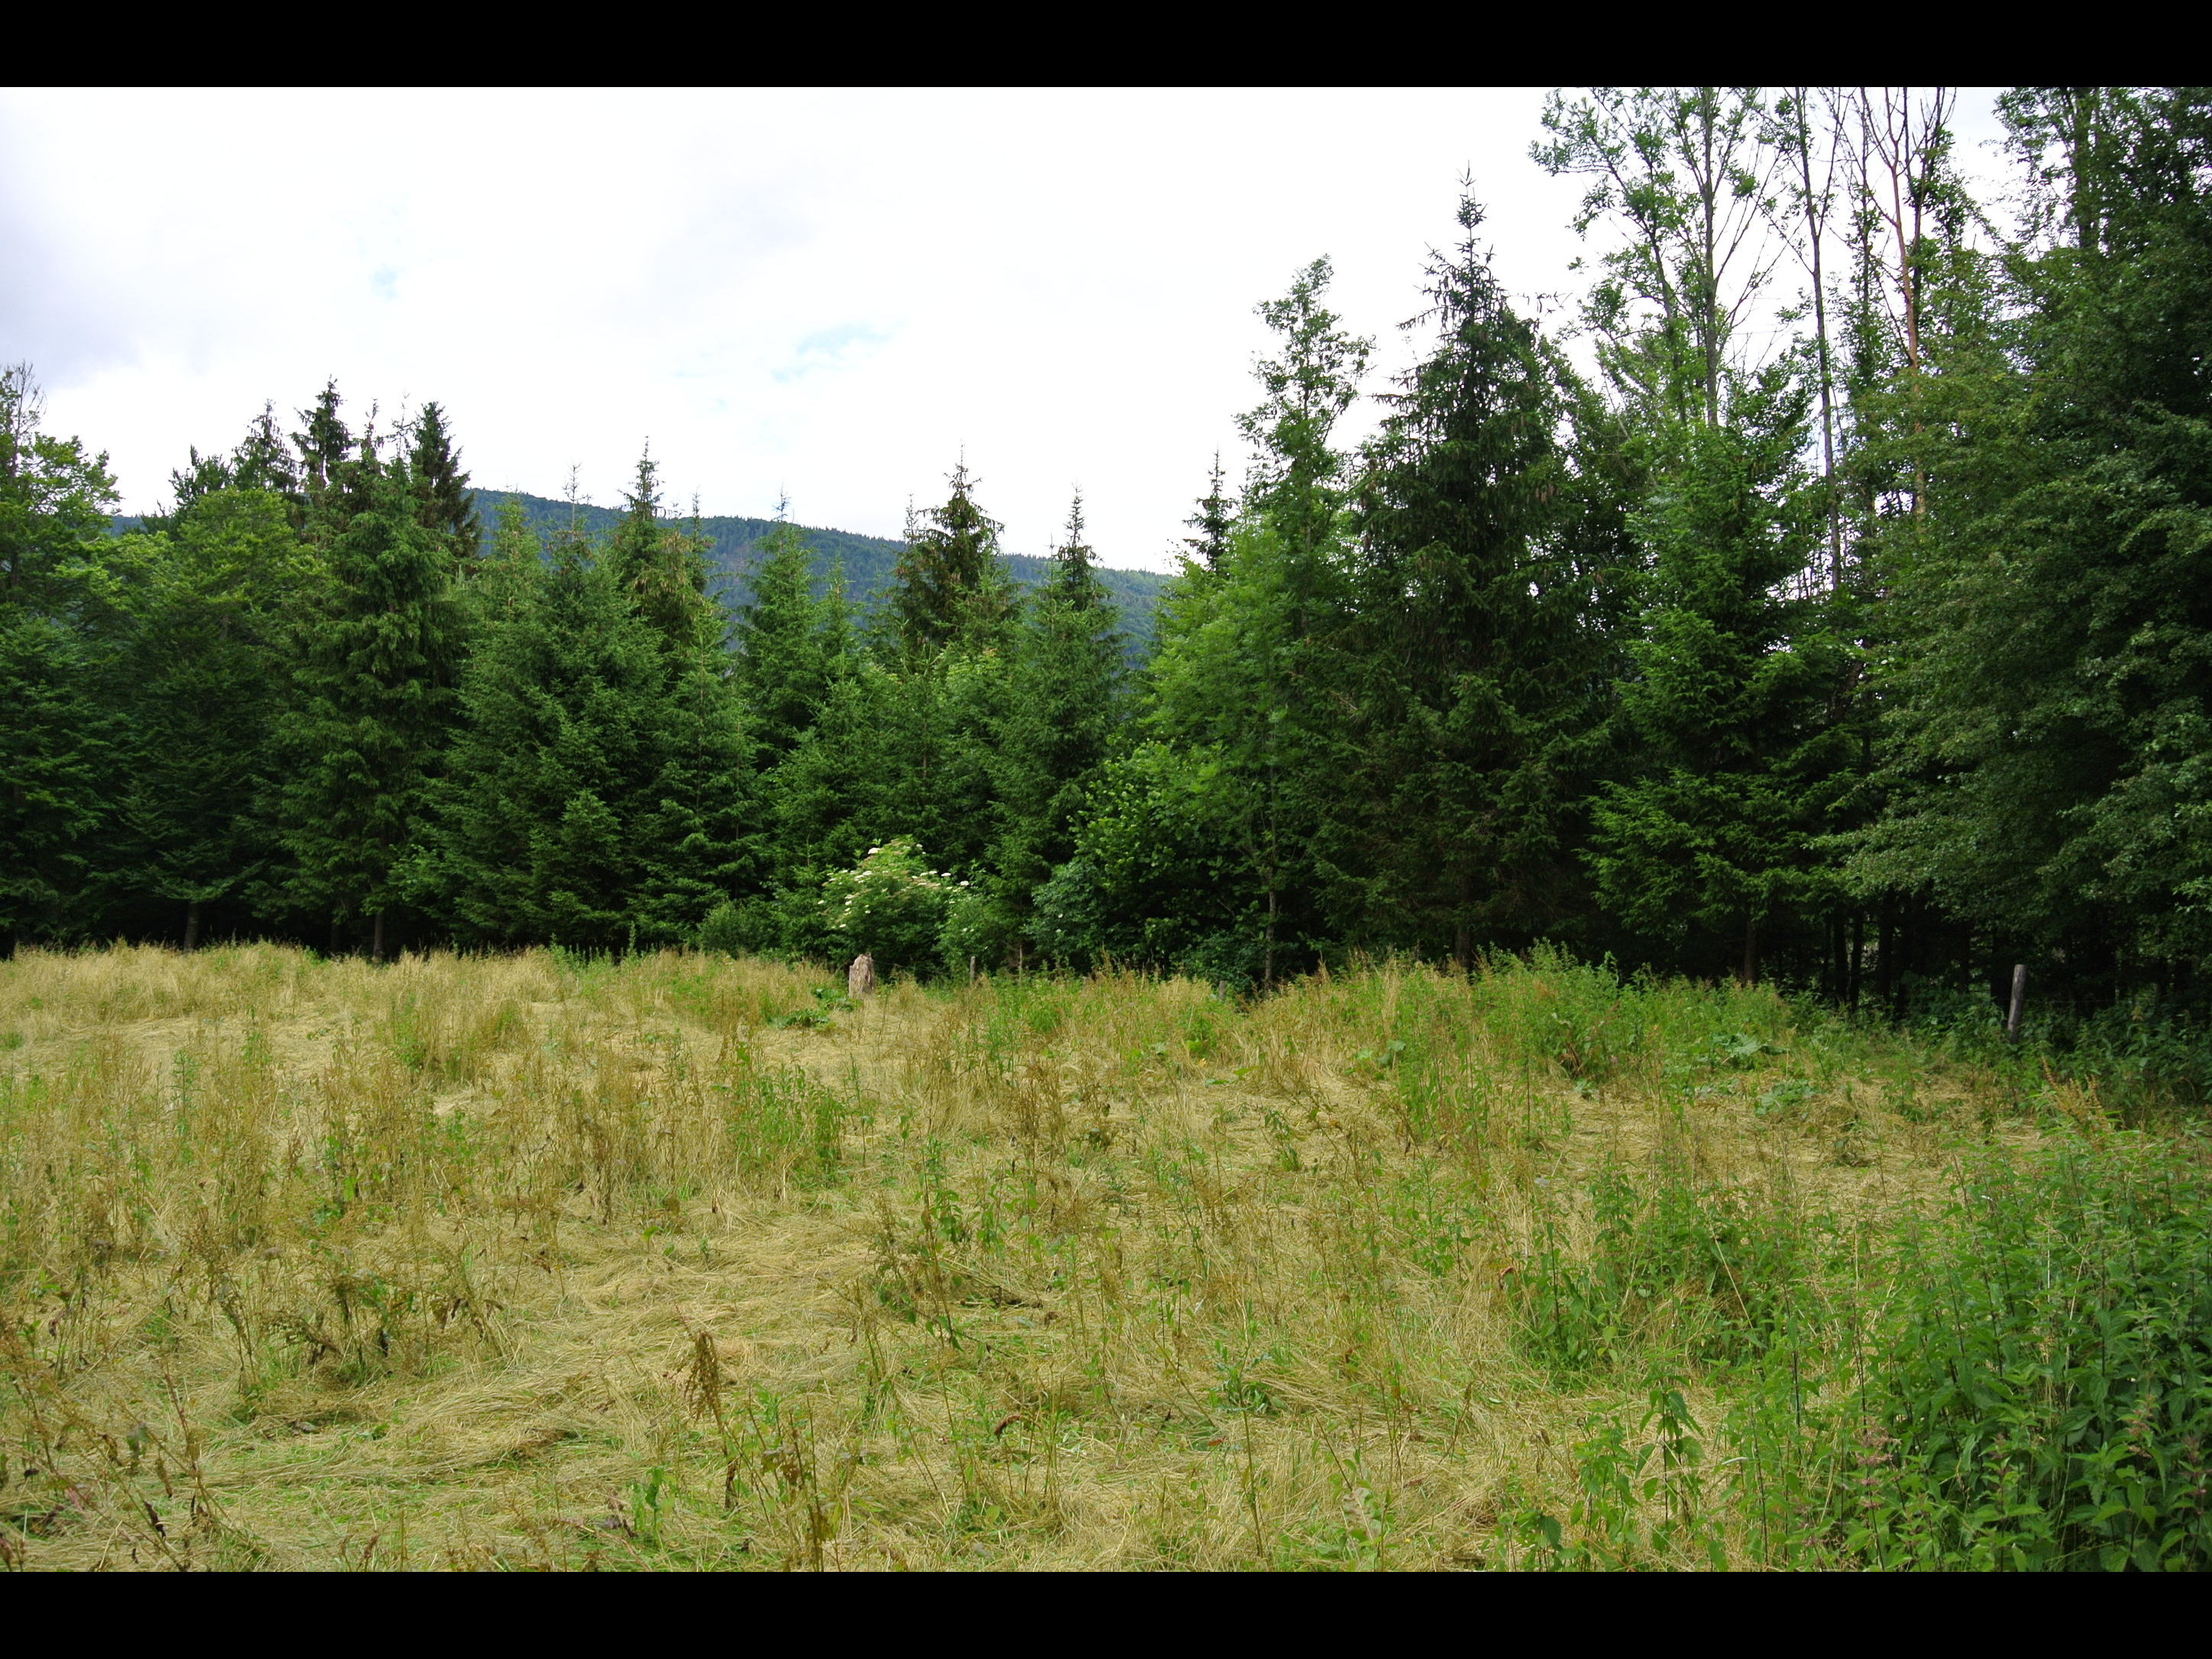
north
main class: Grassland
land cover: Grassland without tree/shrub cover
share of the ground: > 75 %
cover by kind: herbaceous plants 100 %
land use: Agriculture (excluding fallow land and kitchen gardens)
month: June
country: AT
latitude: 47.8480
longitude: 15.5744
